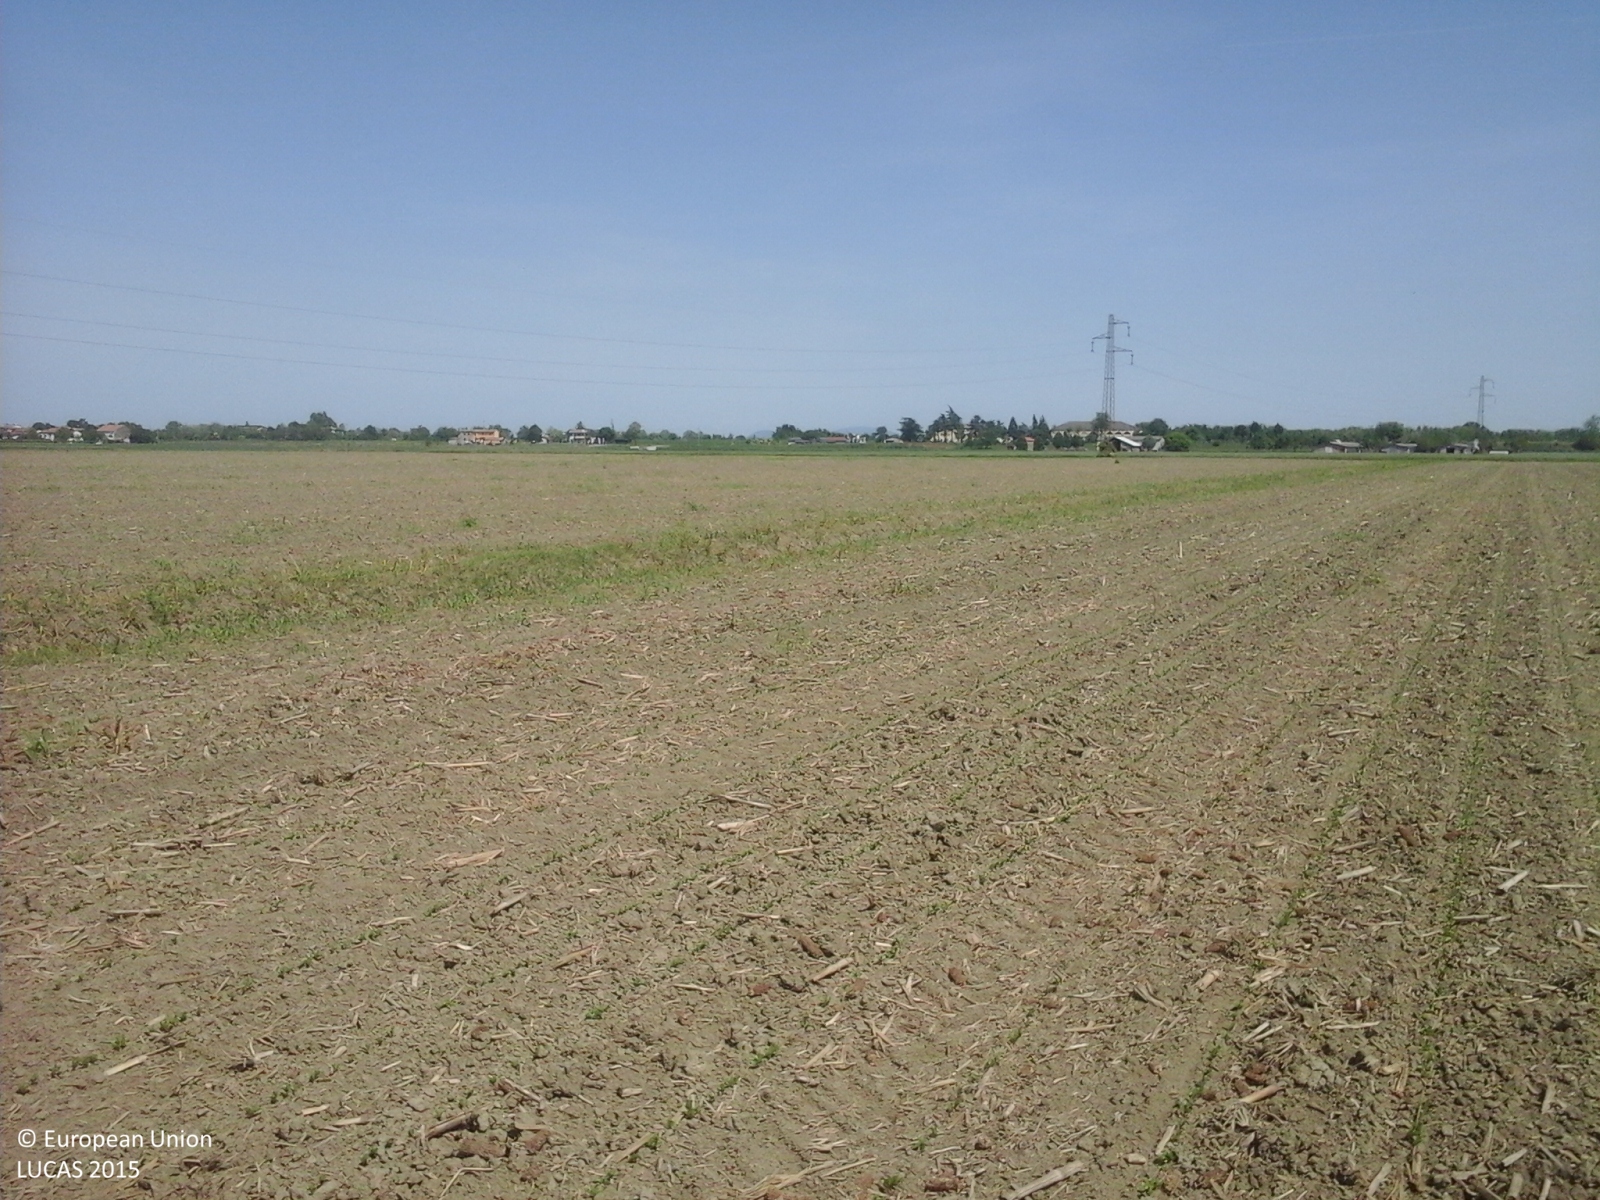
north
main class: Cropland
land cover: Soya
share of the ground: < 10 %
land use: Agriculture (excluding fallow land and kitchen gardens)
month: May
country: IT
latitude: 44.9858
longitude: 11.7089
